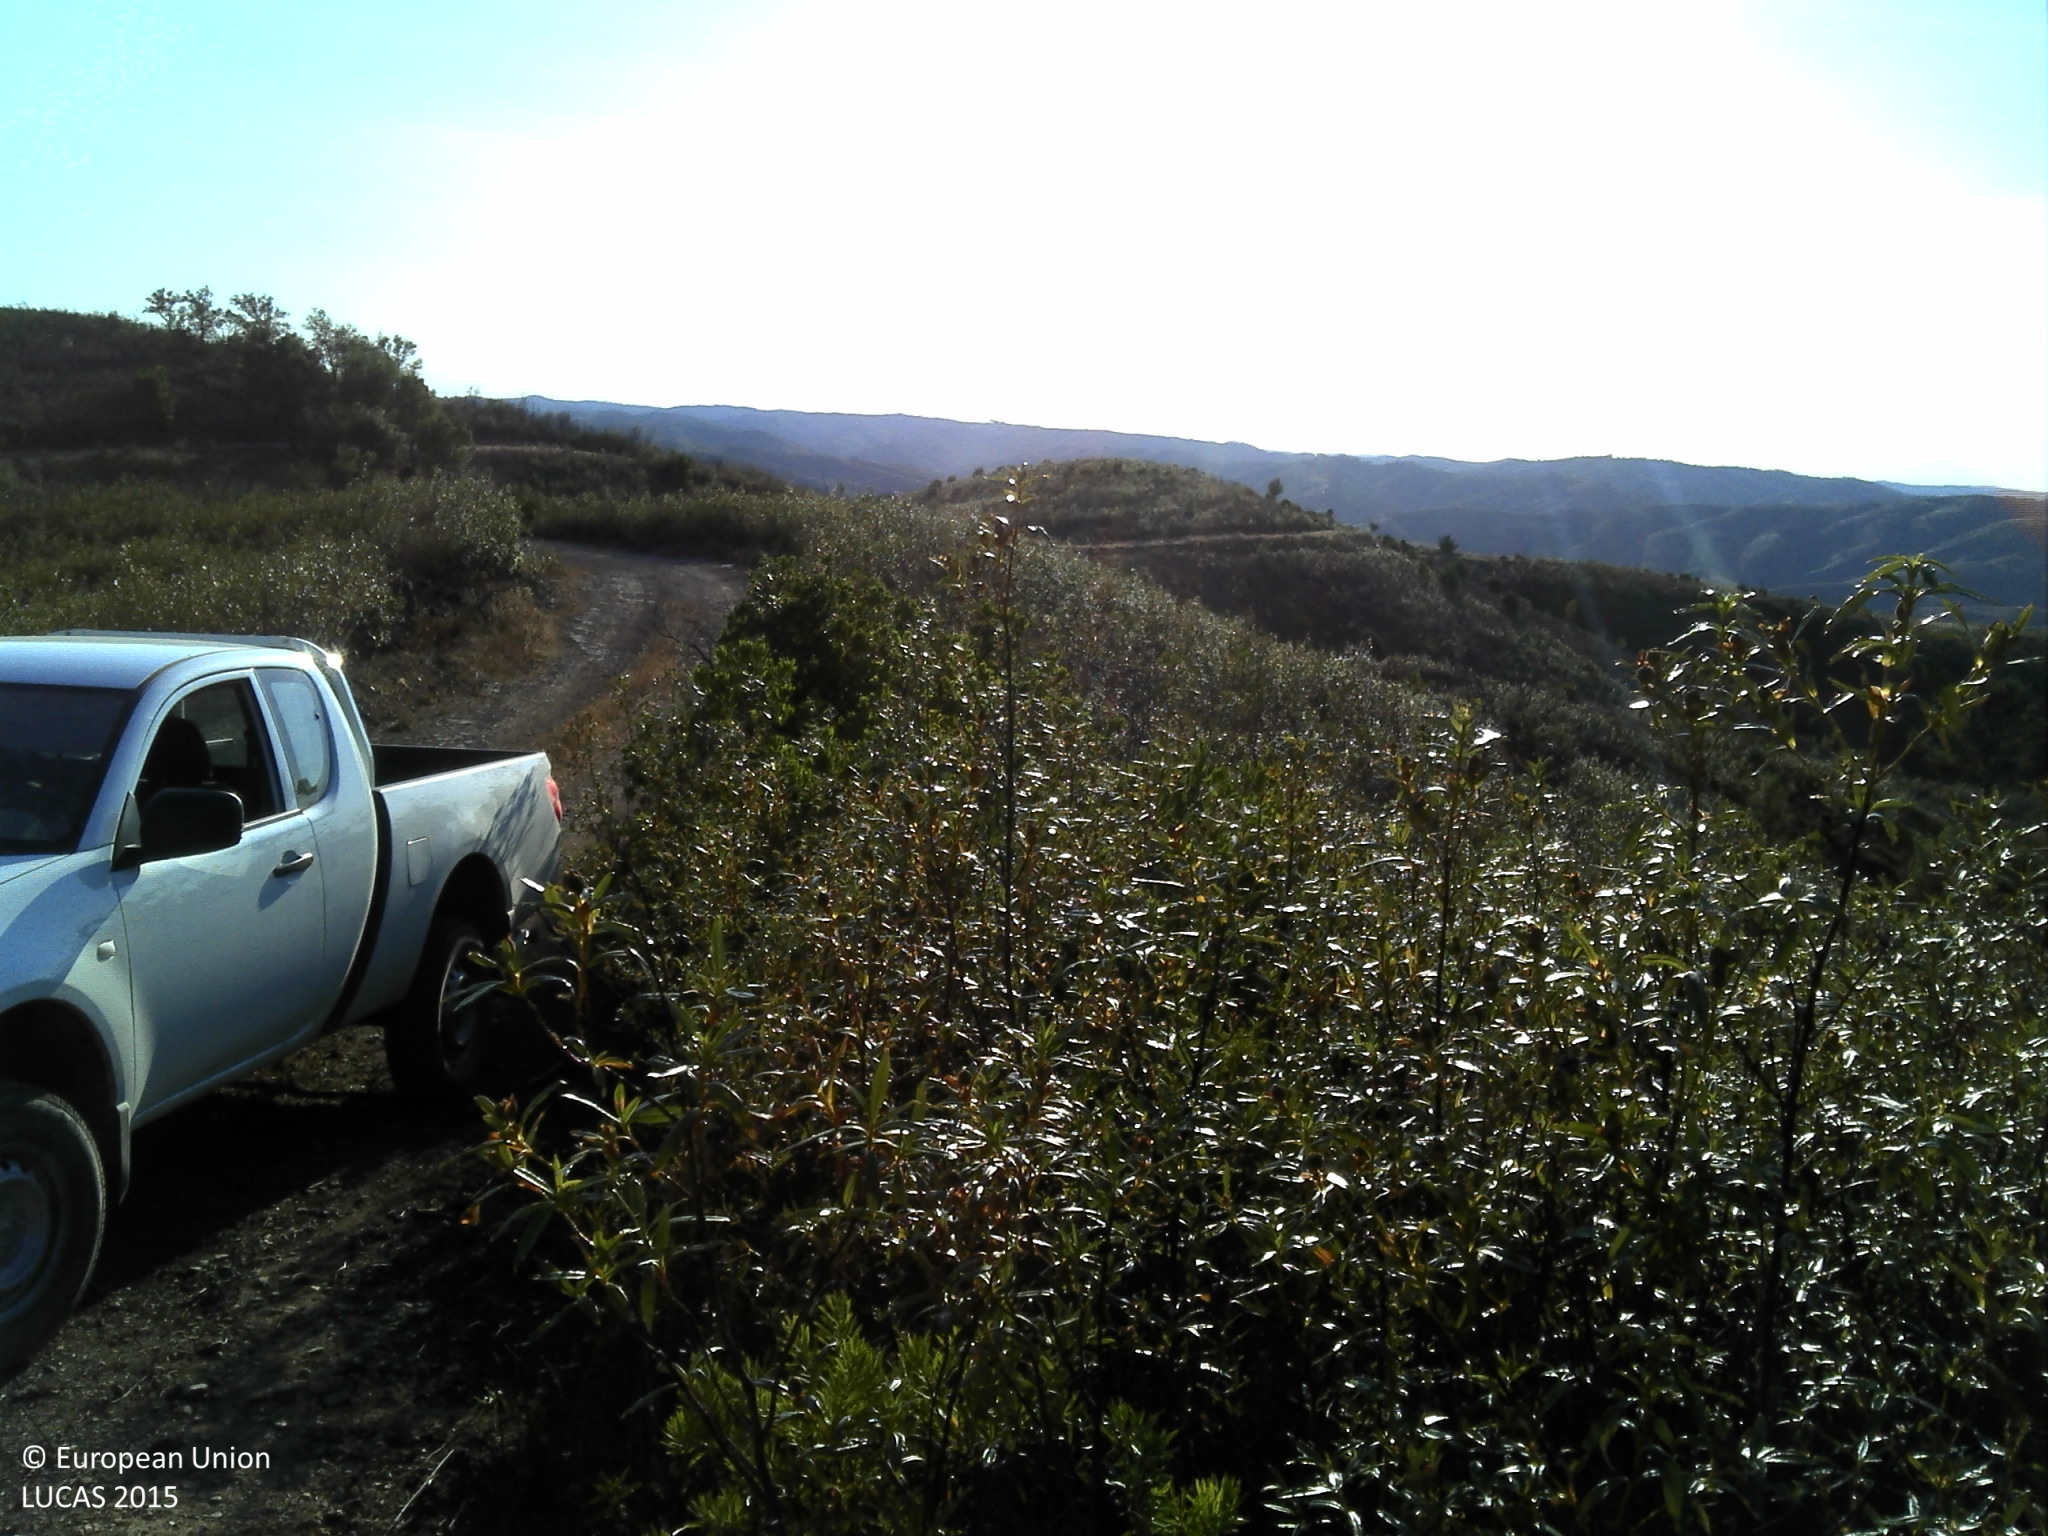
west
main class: Shrubland
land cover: Shrubland with sparse tree cover
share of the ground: > 75 %
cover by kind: shrubs 95 %, broadleaved forest trees 5 %
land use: Abandoned areas
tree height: < 5 m
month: June
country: PT
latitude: 37.2187
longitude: -7.8044
